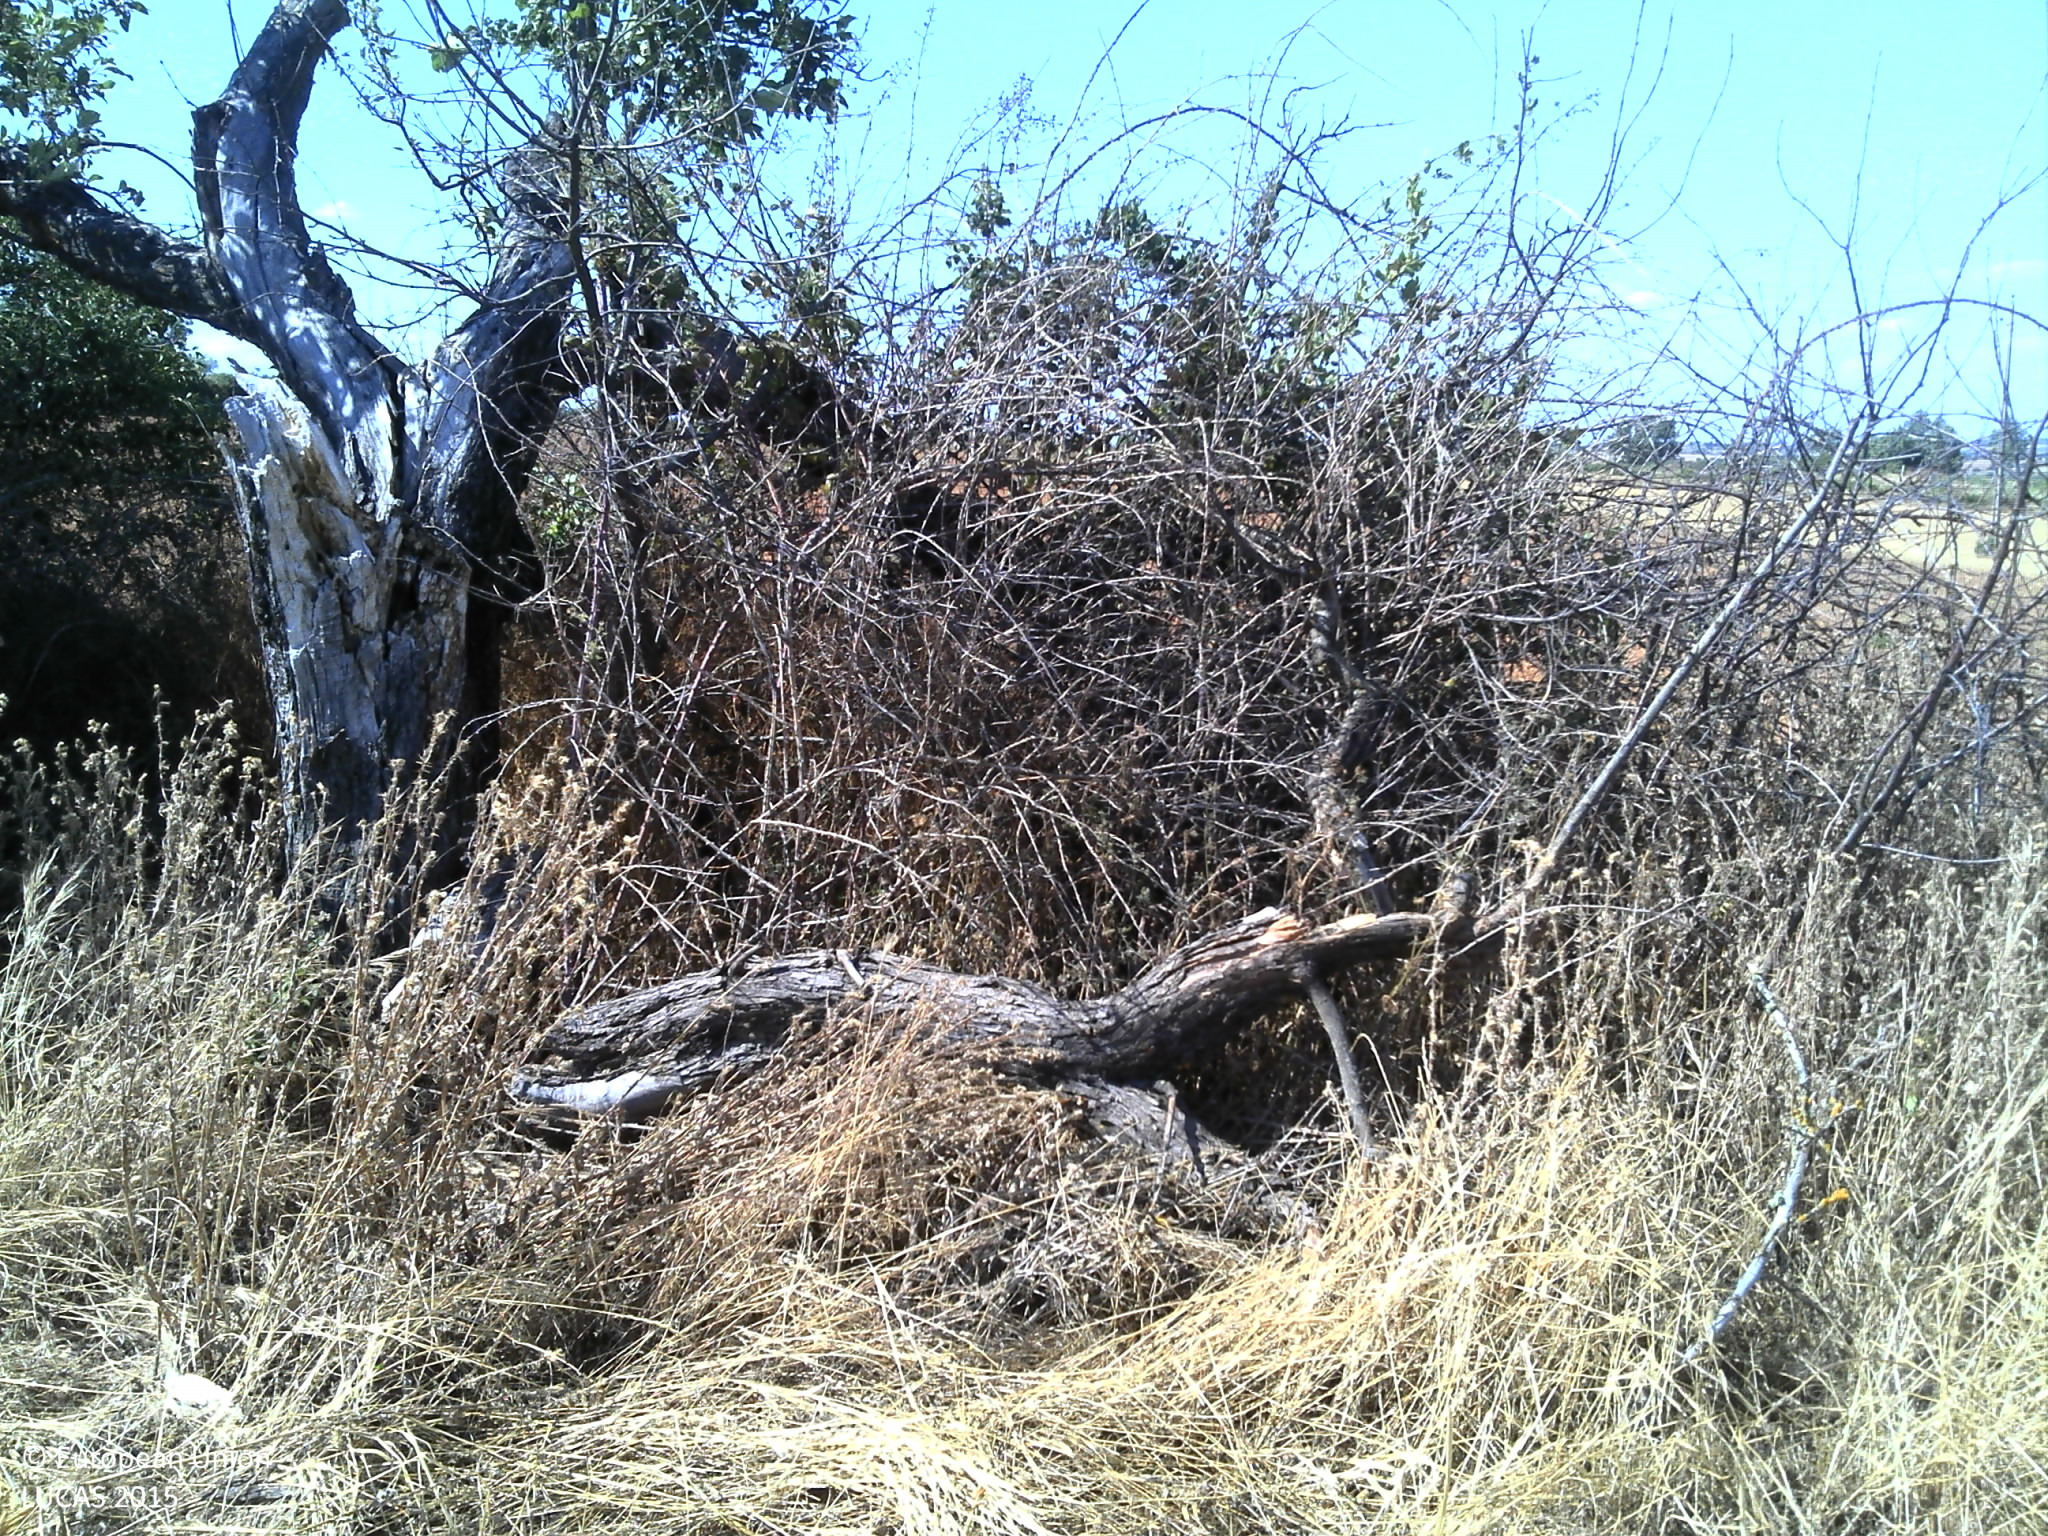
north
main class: Cropland
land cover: Oats
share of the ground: > 75 %
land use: Agriculture (excluding fallow land and kitchen gardens)
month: June
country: PT
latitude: 40.8164
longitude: -6.9011
